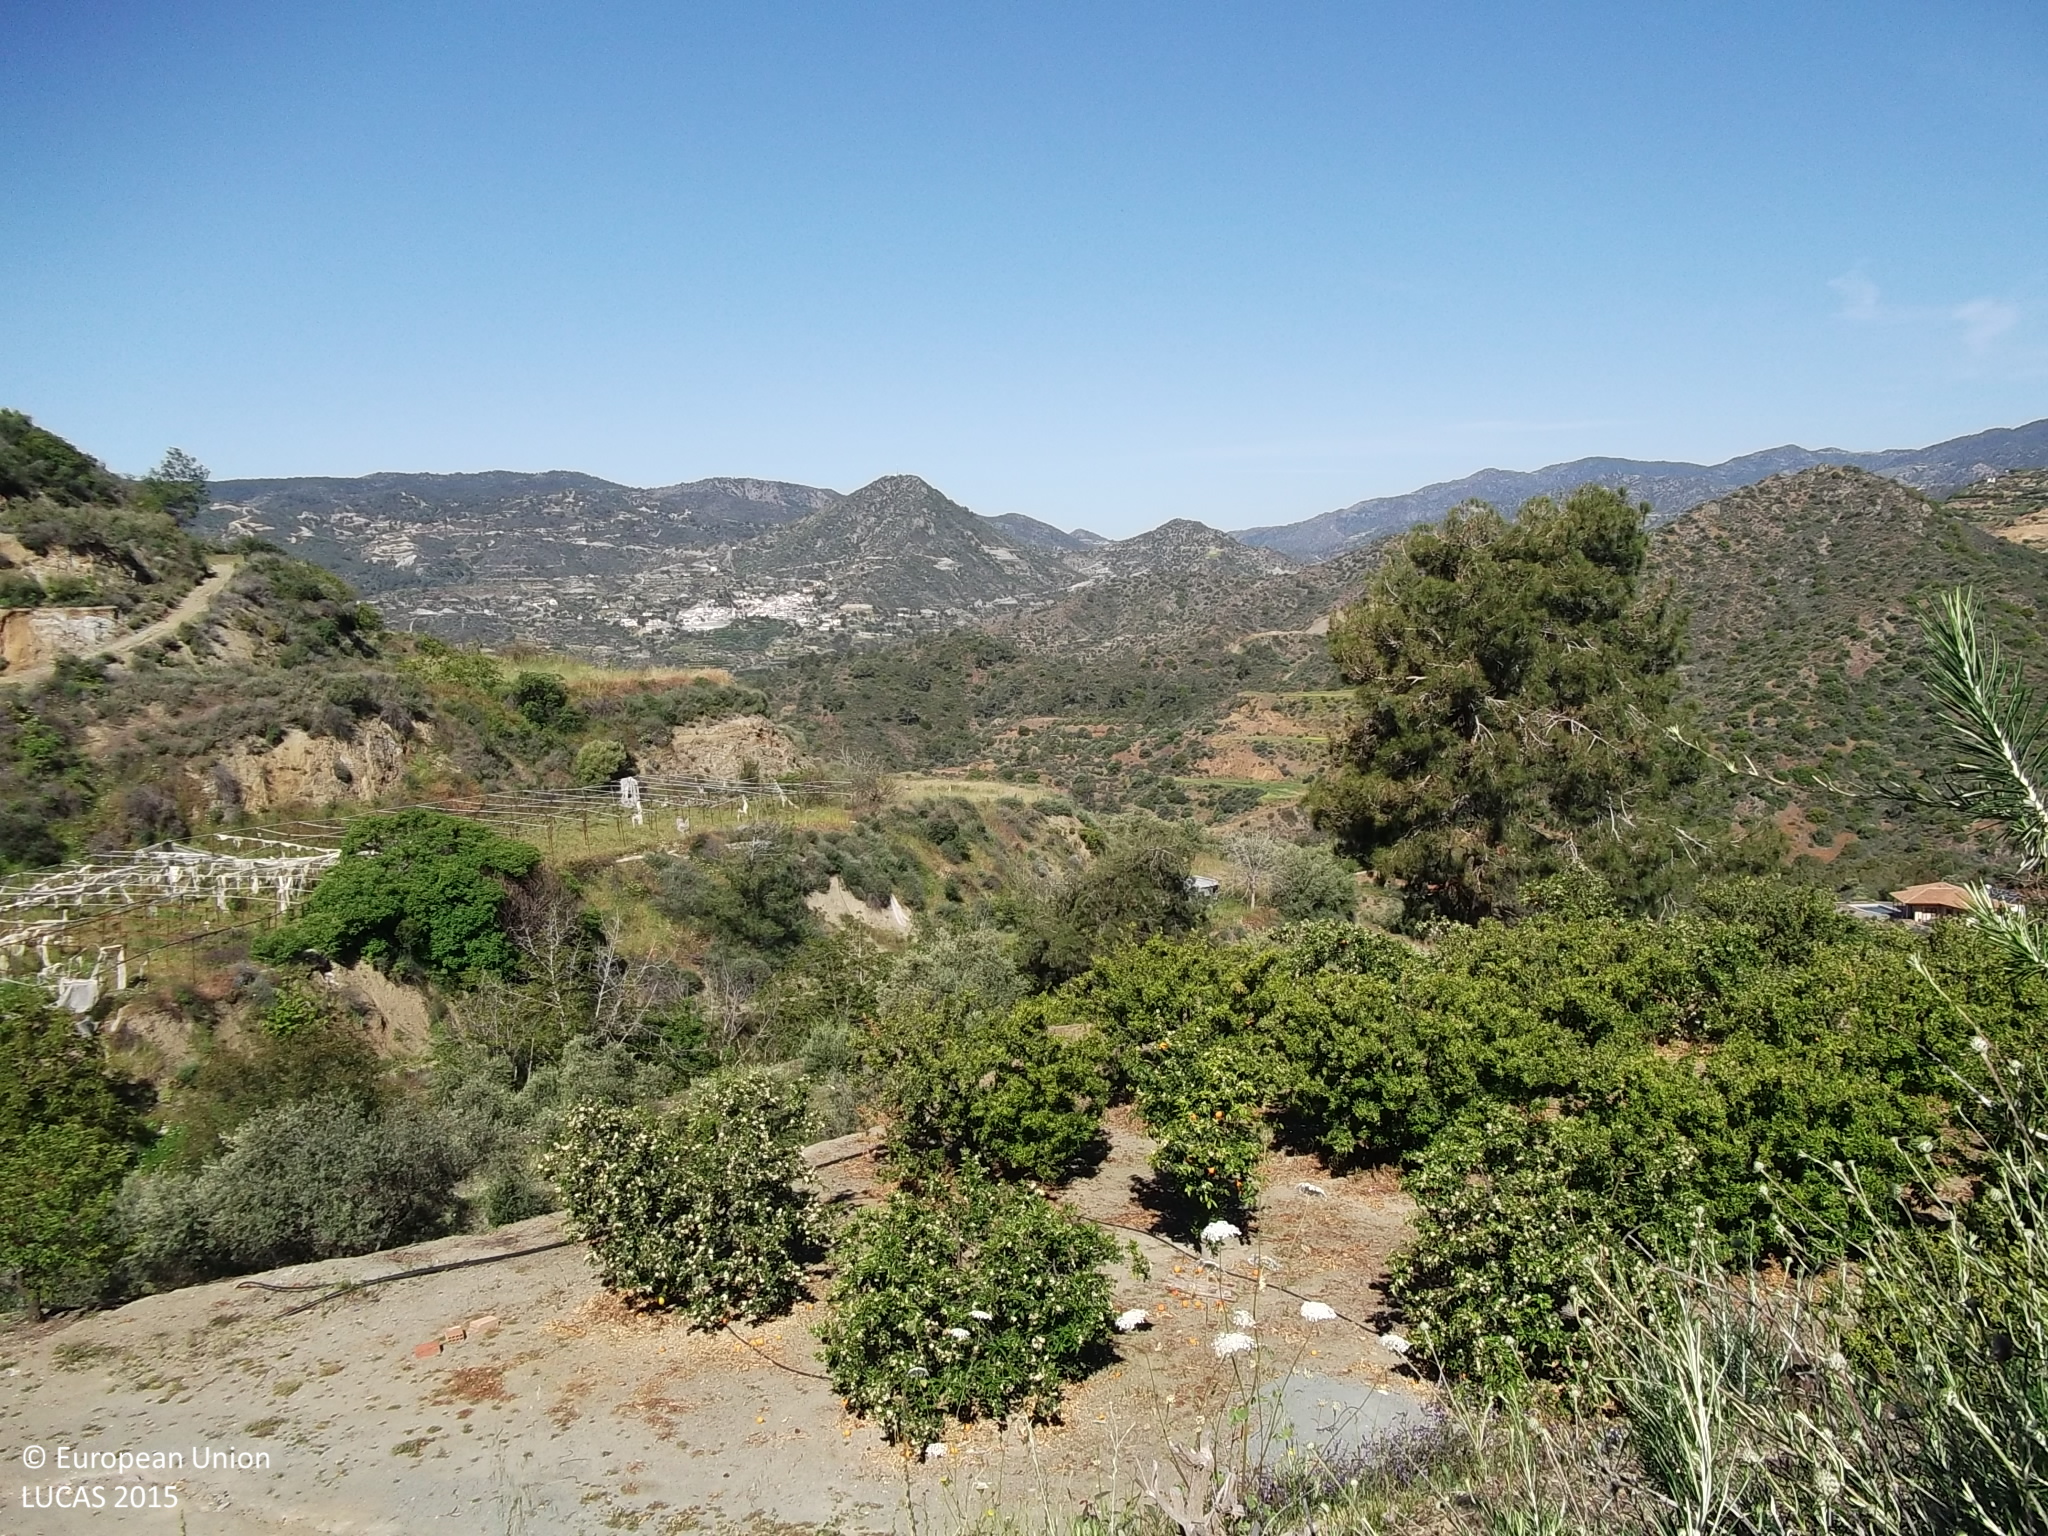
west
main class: Cropland
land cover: Oranges
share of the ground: 50 - 75 %
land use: Agriculture (excluding fallow land and kitchen gardens)
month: April
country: CY
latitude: 34.8313
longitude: 33.1470
